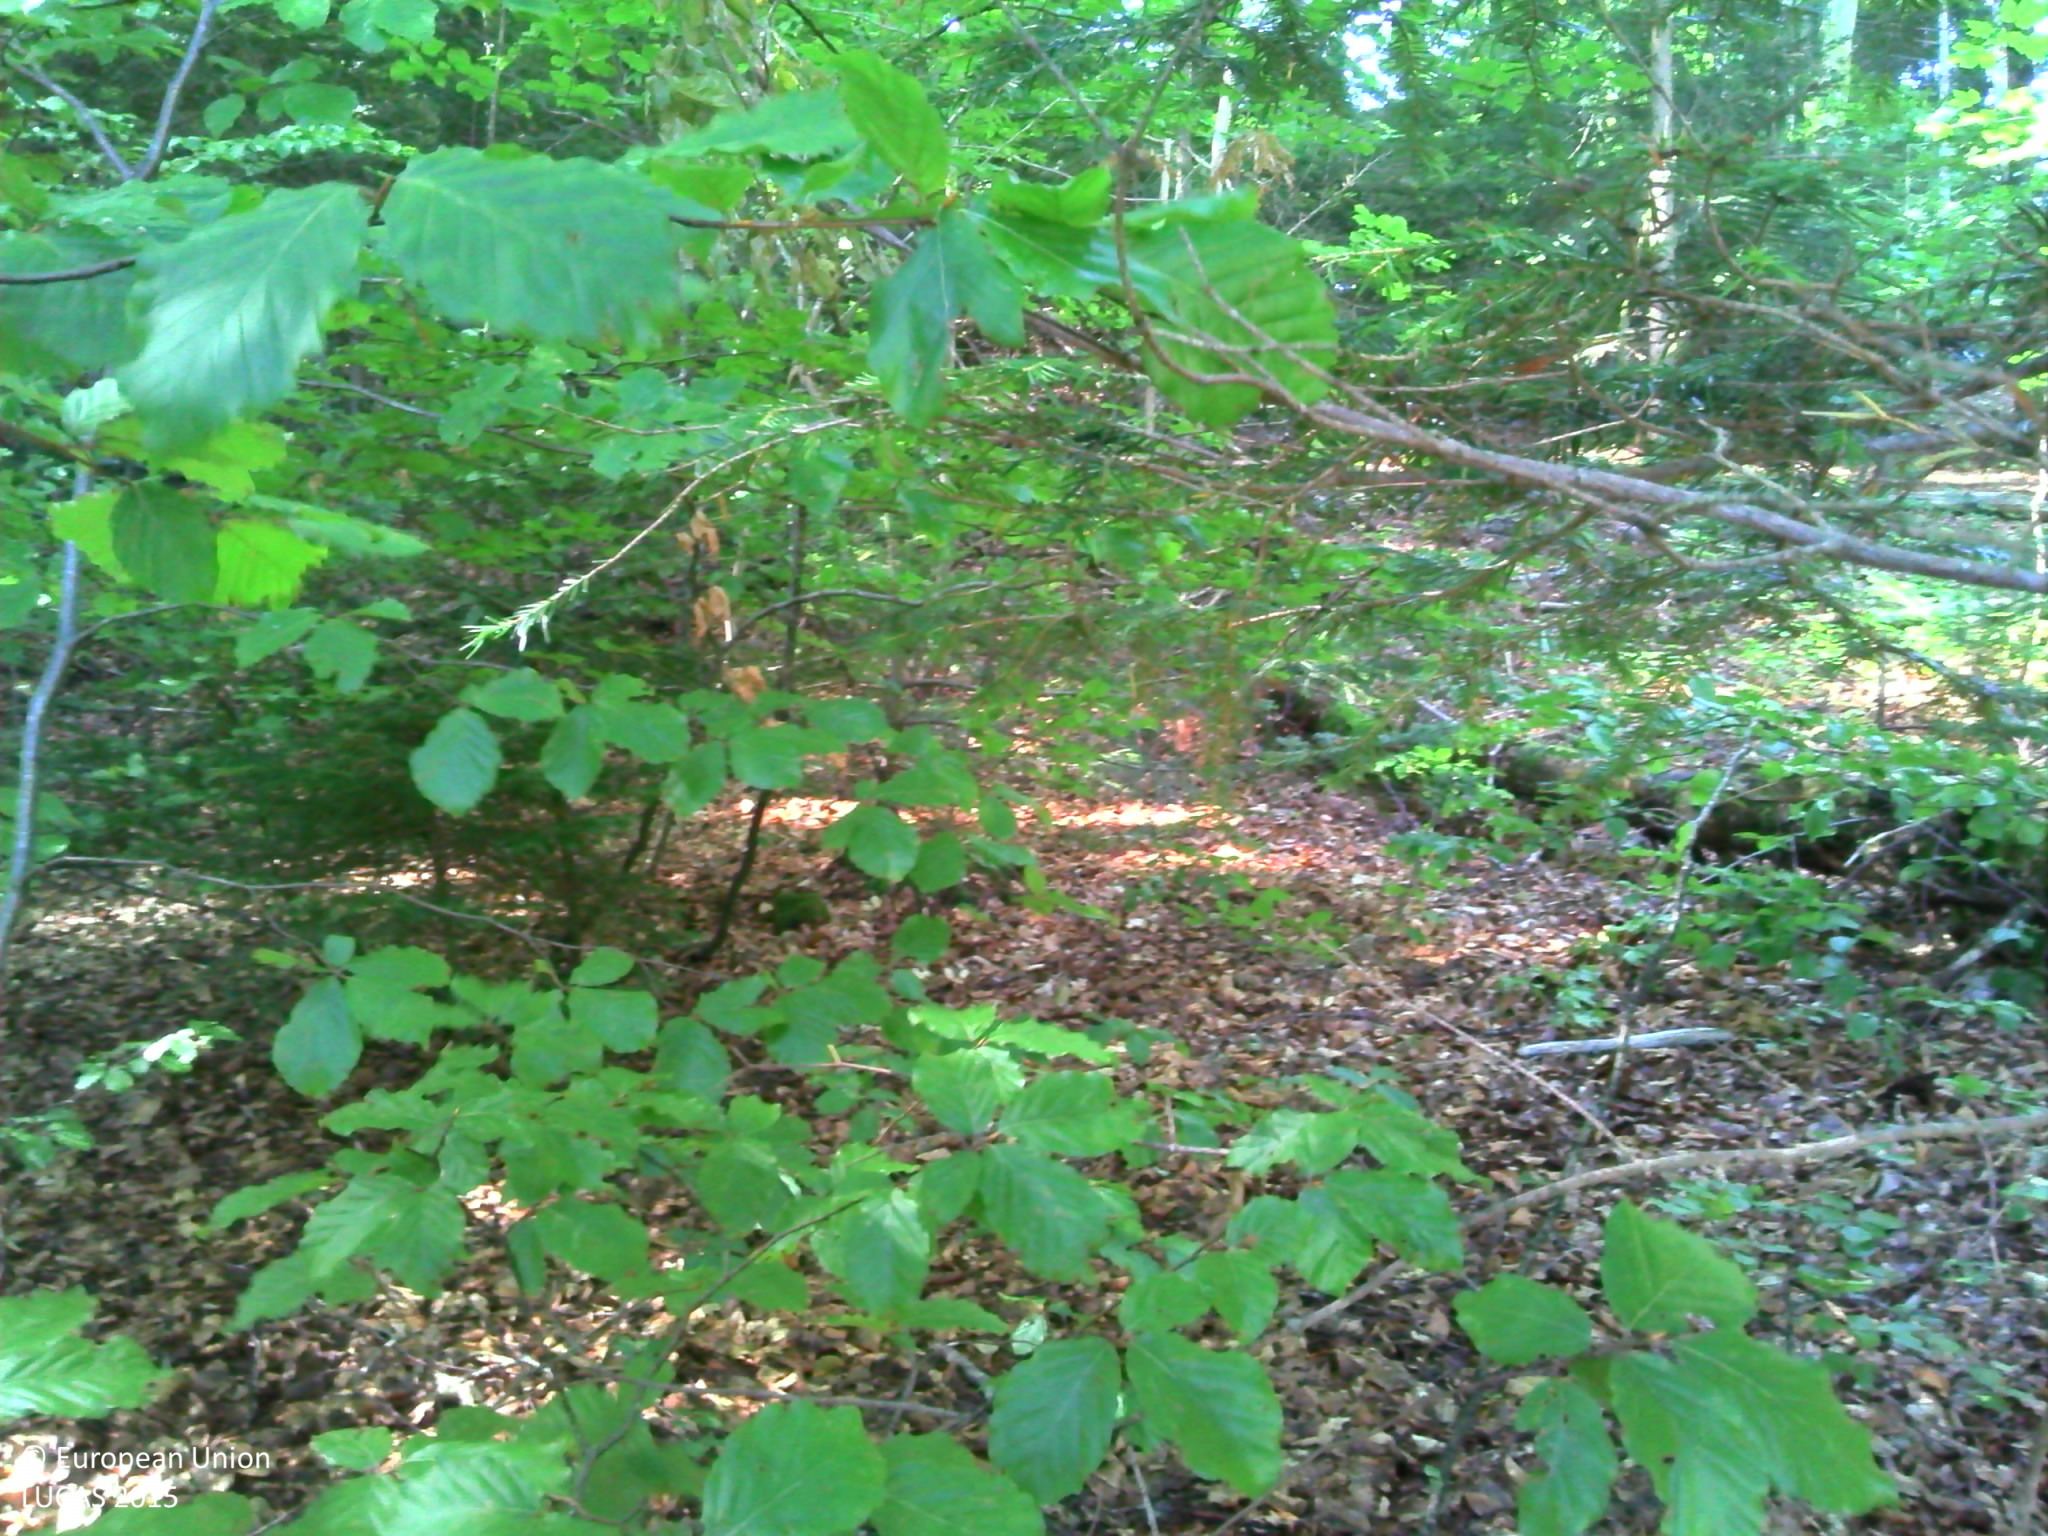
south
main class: Woodland
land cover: Broadleaved woodland
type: beech forest
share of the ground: > 75 %
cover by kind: broadleaved forest trees 70 %, coniferous forest trees 15 %, herbaceous plants 10 %, lichens and mosses 5 %
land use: Forestry
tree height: > 5 m
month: July
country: FR
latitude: 46.0679
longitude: 6.2157
